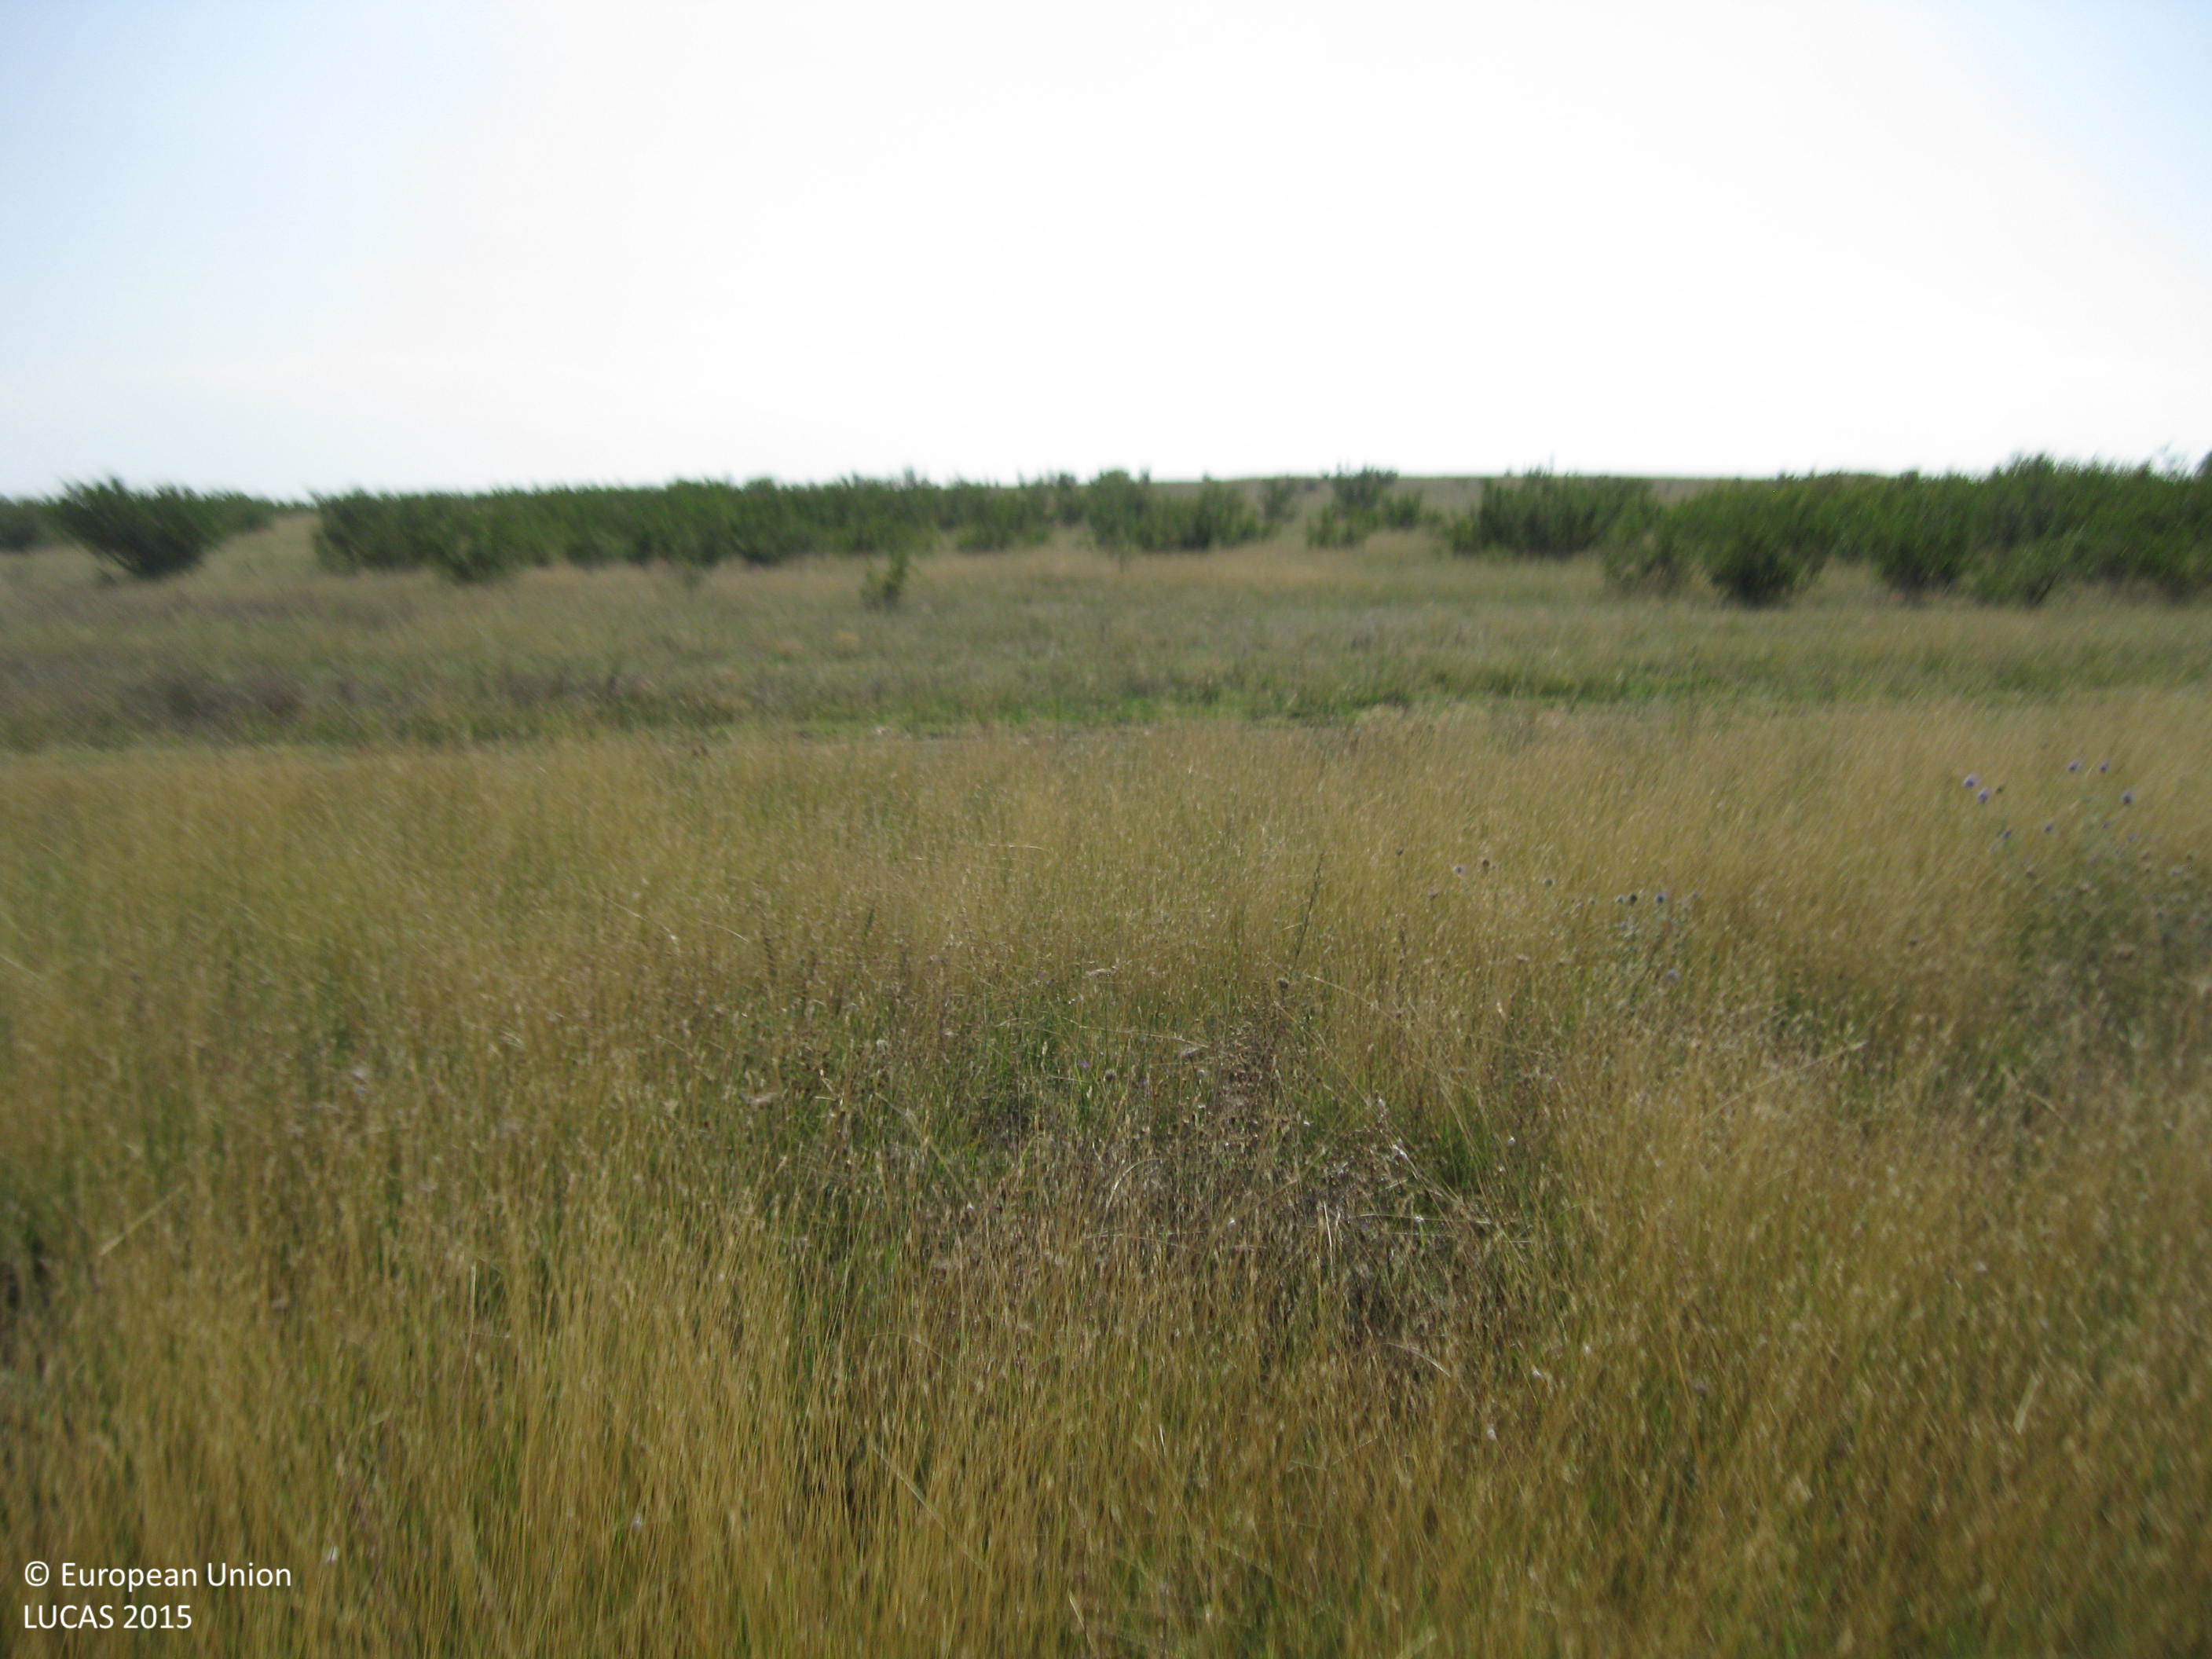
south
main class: Grassland
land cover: Grassland without tree/shrub cover
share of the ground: > 75 %
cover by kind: herbaceous plants 95 %, shrubs 5 %
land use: Agriculture (excluding fallow land and kitchen gardens)
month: September
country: BG
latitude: 42.2340
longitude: 25.0718
